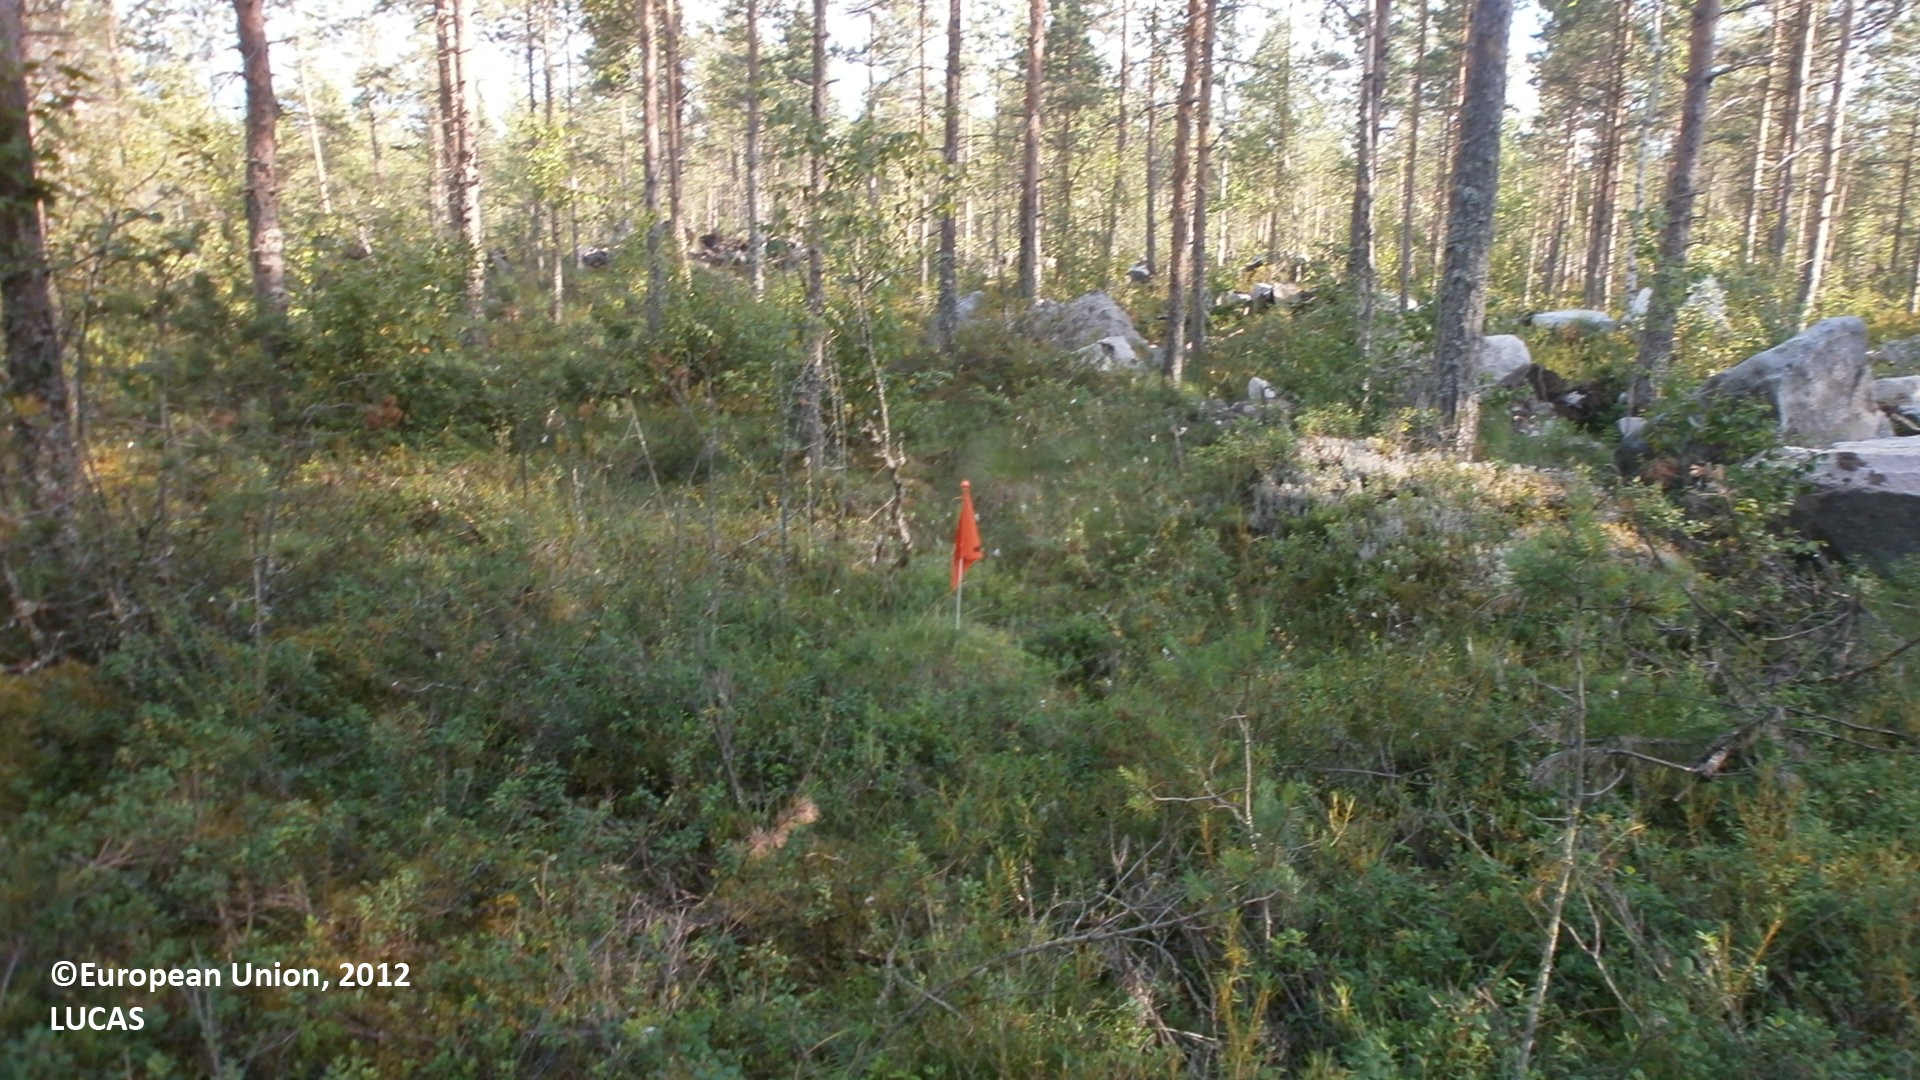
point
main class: Woodland
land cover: Pine dominated coniferous woodland
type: mire and swamp forests
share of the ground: 50 - 75 %
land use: Forestry
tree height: > 5 m
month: July
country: FI
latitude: 64.0971
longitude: 24.2879
